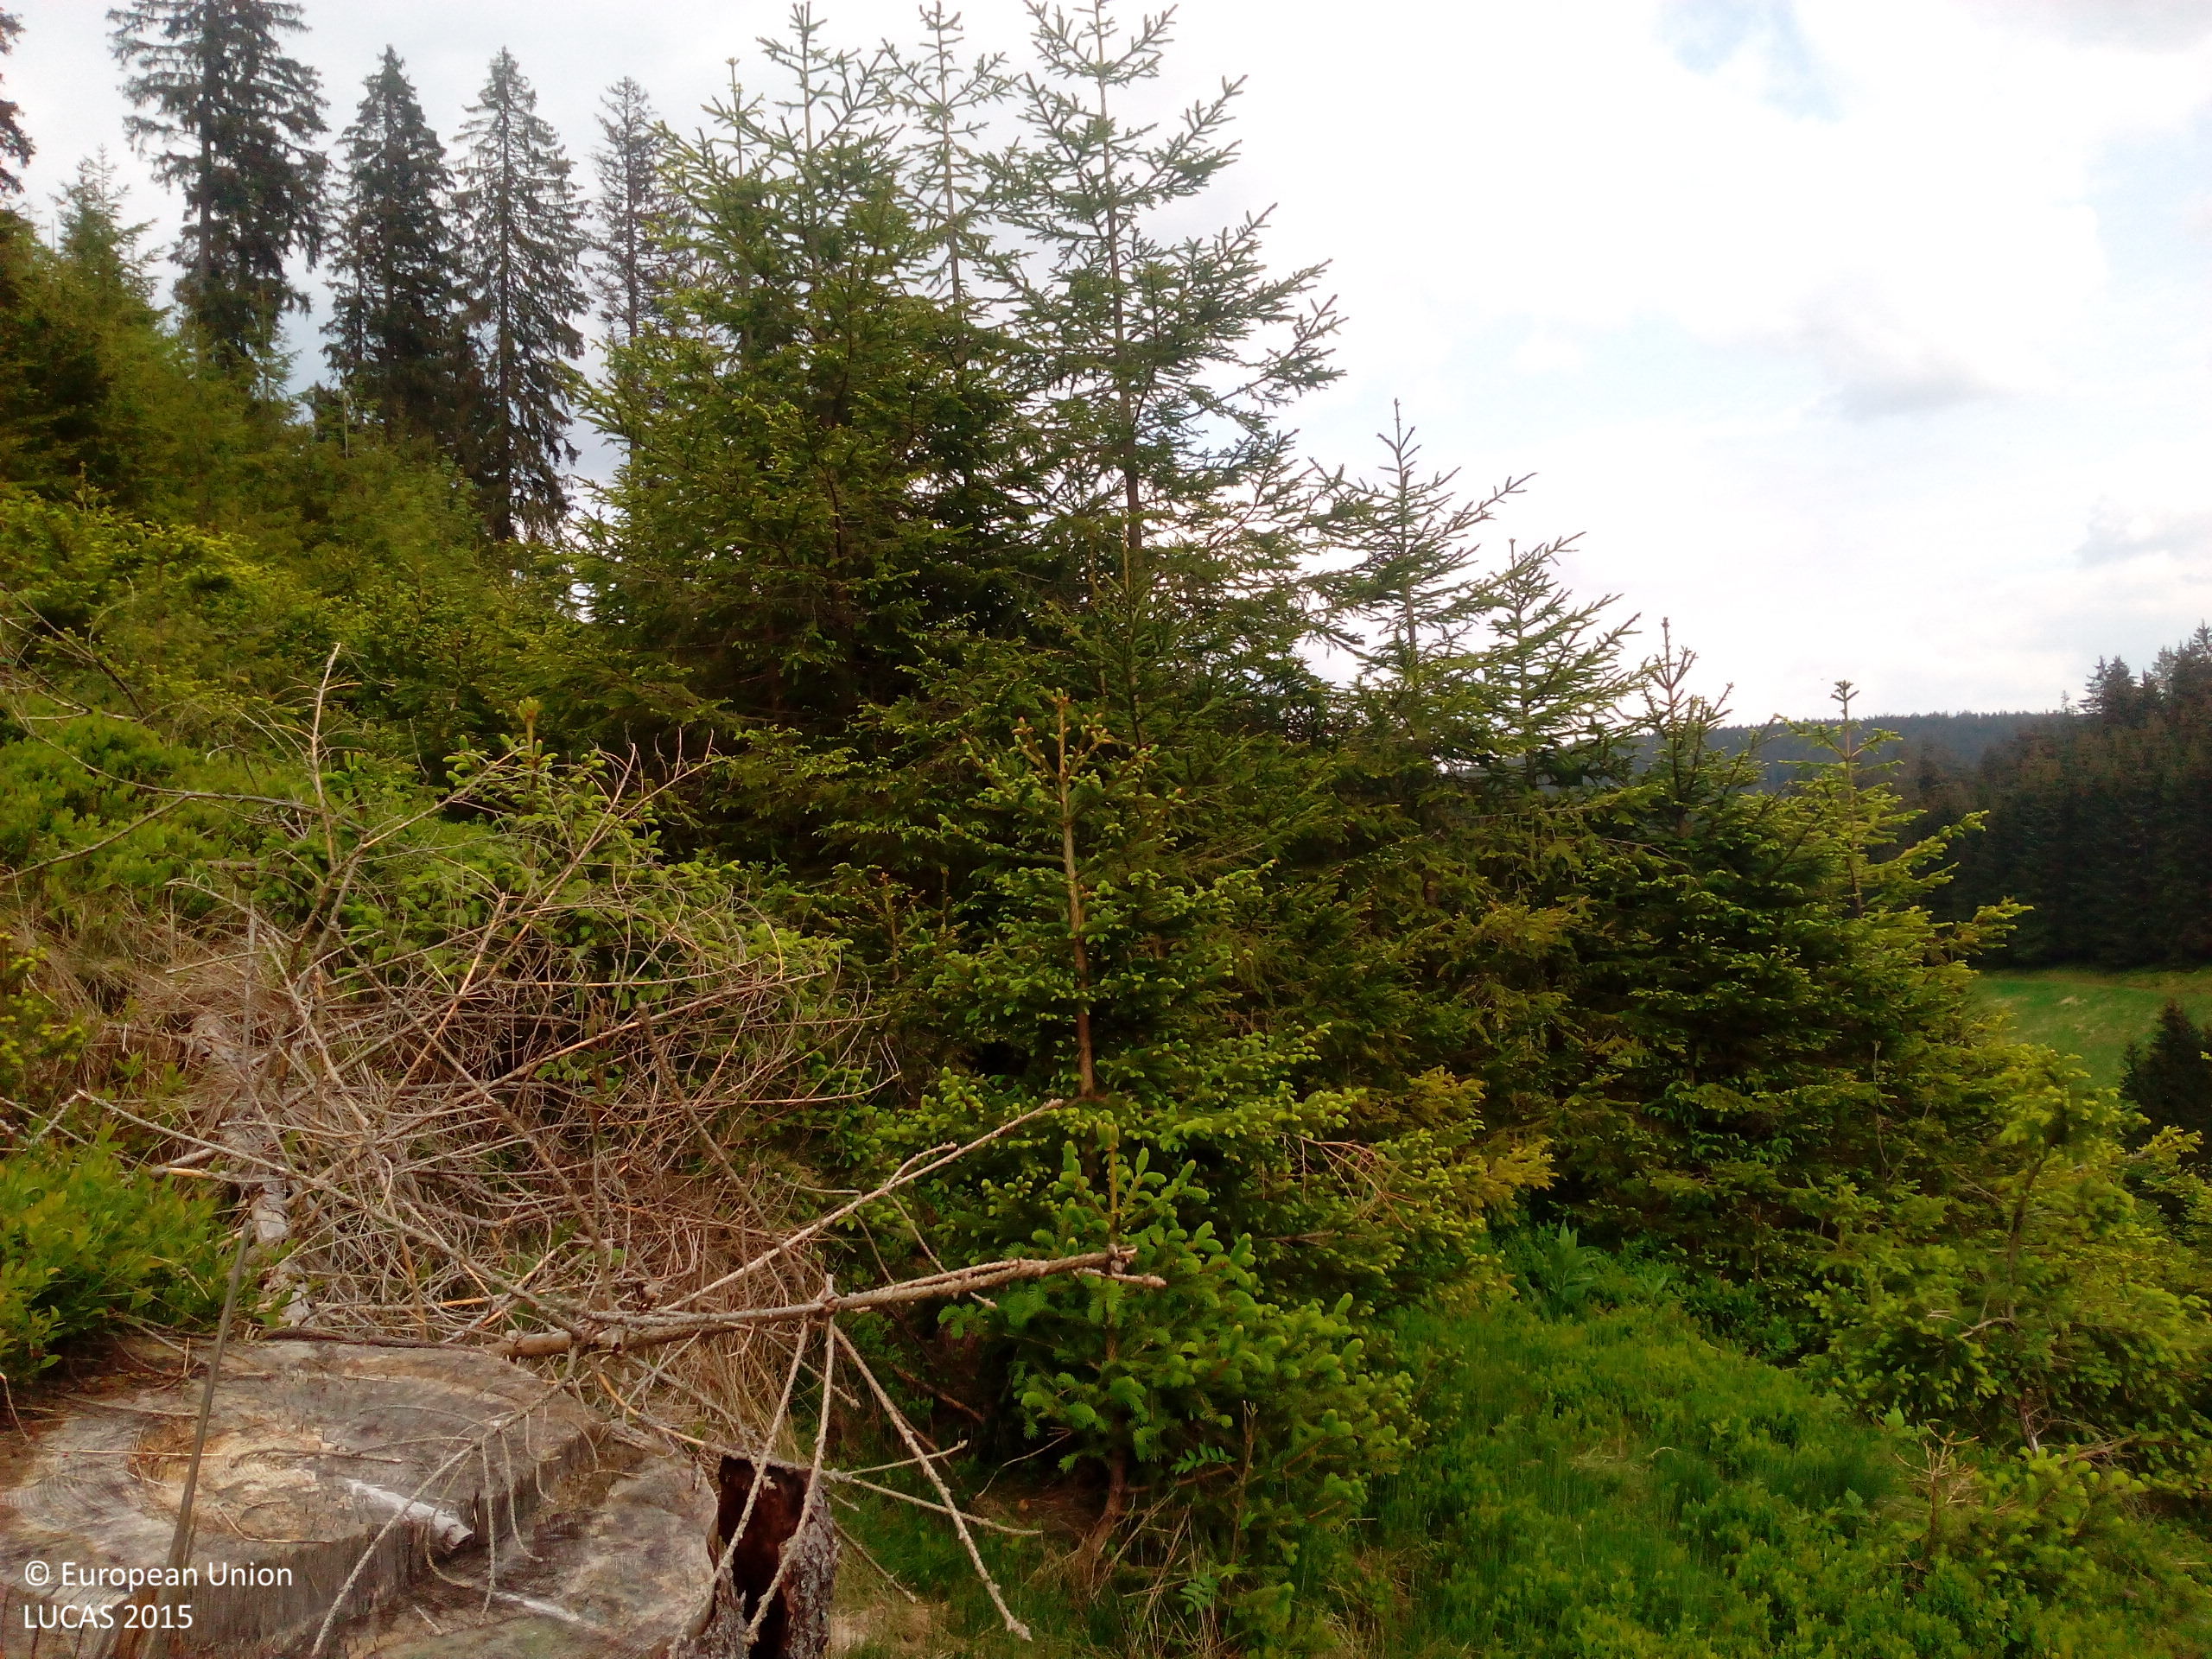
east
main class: Woodland
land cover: Spruce dominated coniferous woodland
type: hemiboreal forest and nemoral coniferous forest and mixed broadleaved-coniferous forest
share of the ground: 25 - 50 %
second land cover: Shrubland without tree cover
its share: 50 - 75 %
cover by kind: coniferous forest trees 40 %, shrubs 40 %, herbaceous plants 20 %
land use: Forestry
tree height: < 5 m
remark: Clear cut
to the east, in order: Spruce dominated coniferous woodland; Shrubland without tree cover; Other coniferous woodland; Grassland with sparse tree/shrub cover; Tracks; Grassland without tree/shrub cover; Abandoned hedges
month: May
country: DE
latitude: 48.0647
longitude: 8.1894
